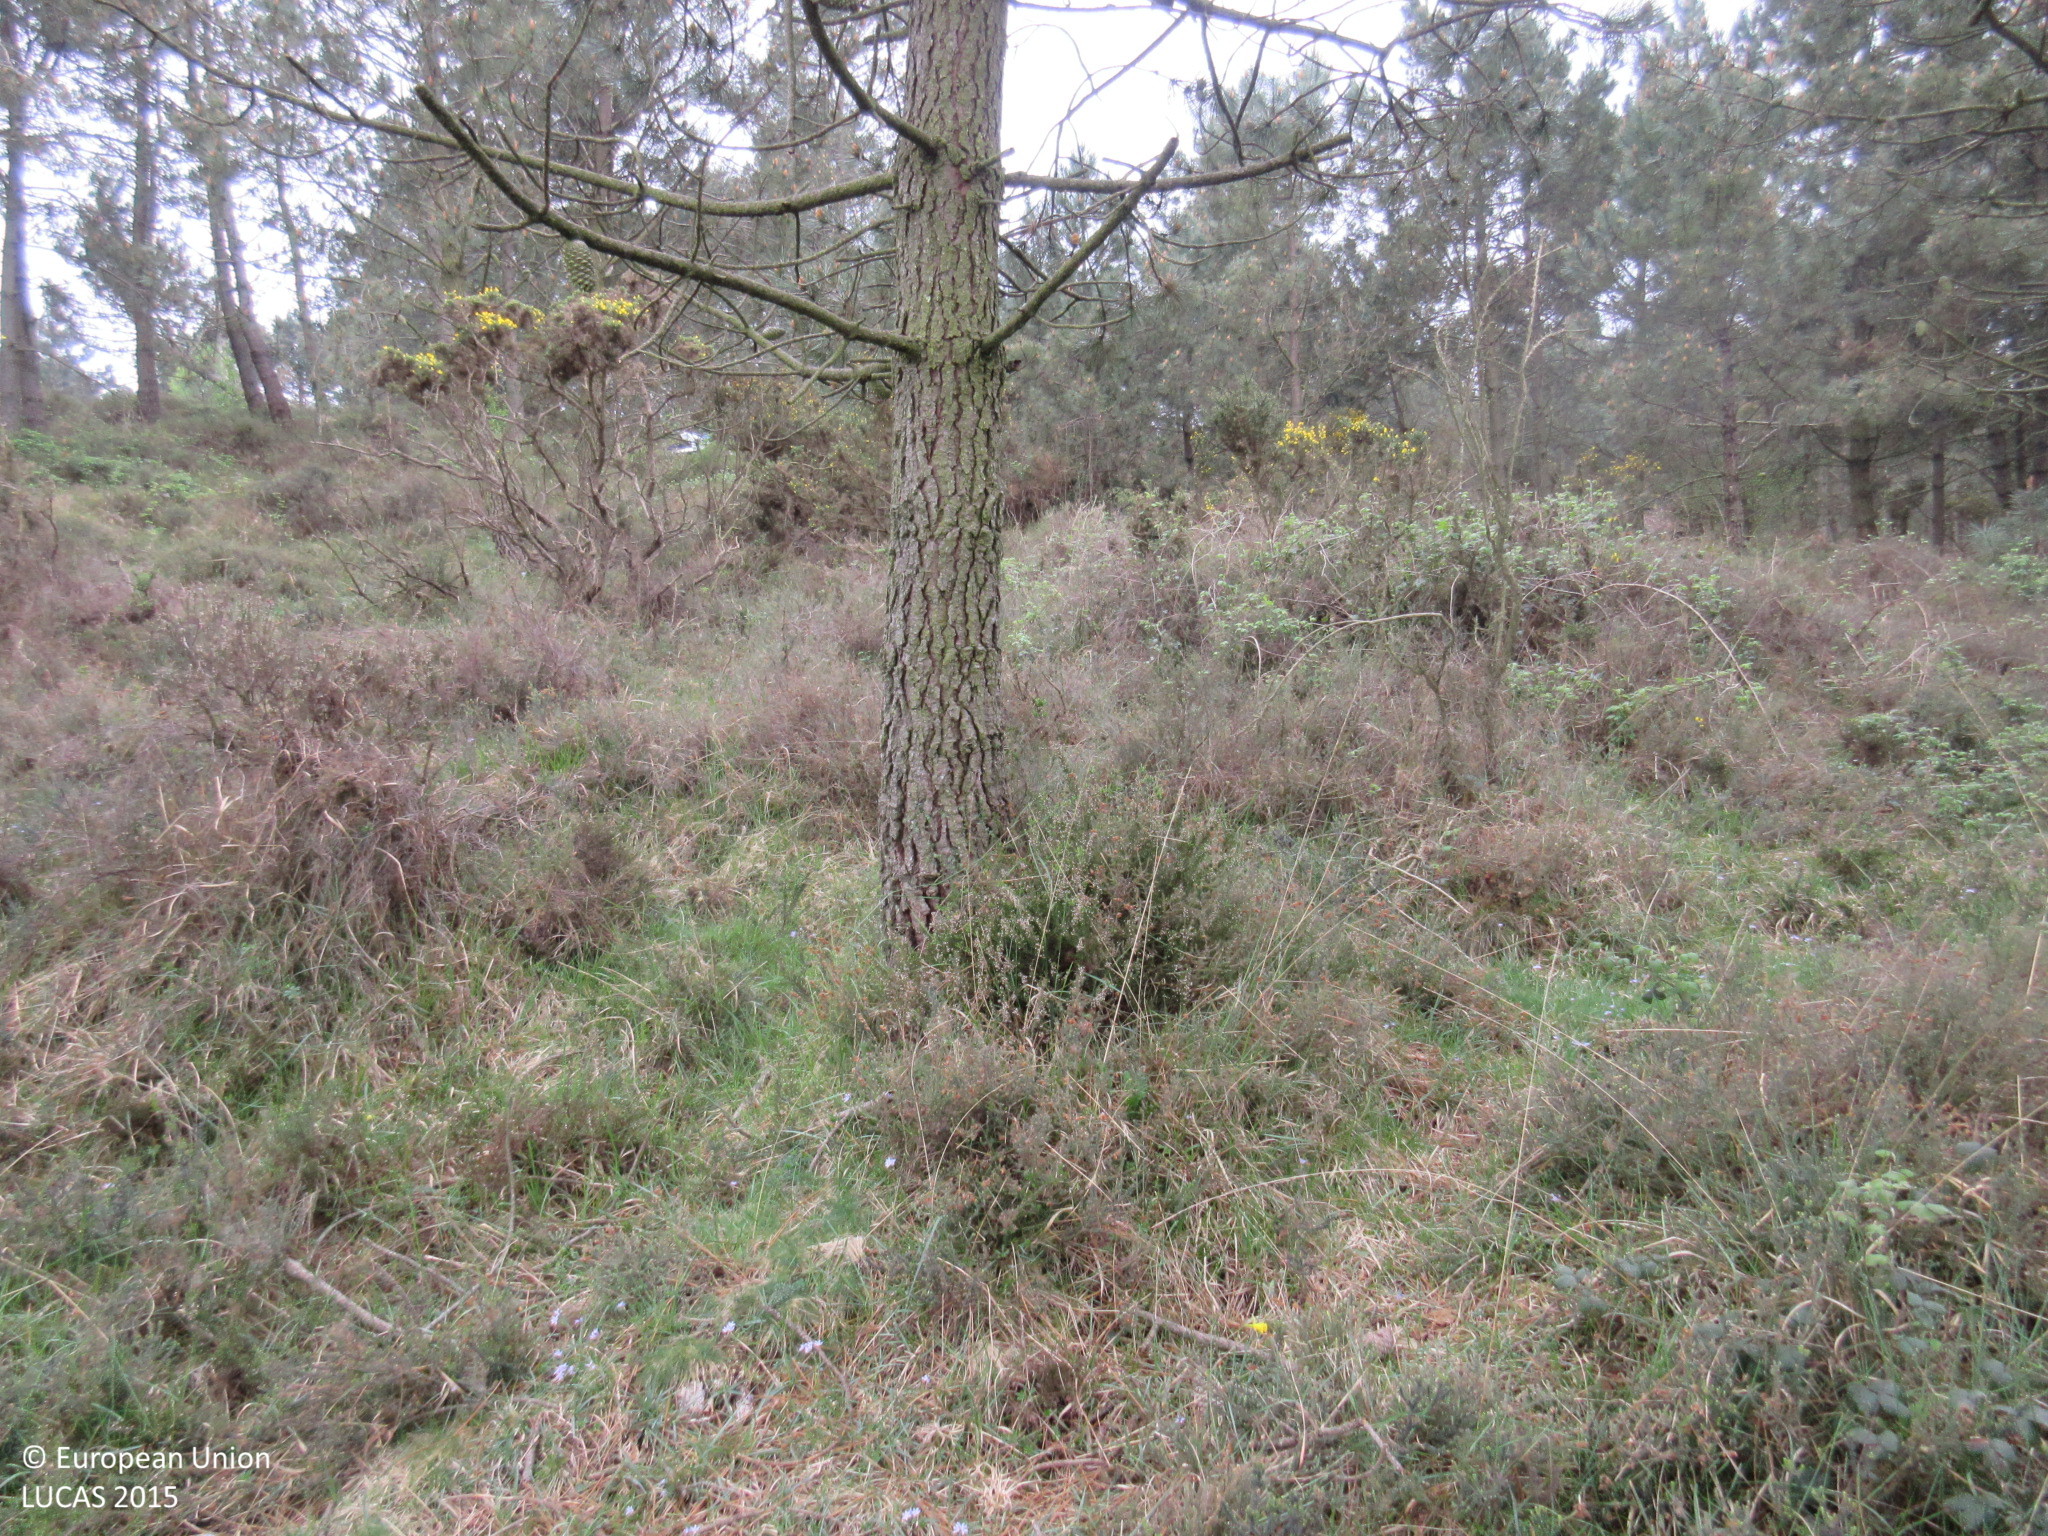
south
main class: Woodland
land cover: Pine dominated coniferous woodland
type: hemiboreal forest and nemoral coniferous forest and mixed broadleaved-coniferous forest
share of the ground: 50 - 75 %
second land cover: Shrubland without tree cover
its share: > 75 %
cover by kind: coniferous forest trees 70 %, shrubs 30 %
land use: Forestry
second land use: Agriculture (excluding fallow land and kitchen gardens)
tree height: > 5 m
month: April
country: ES
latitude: 43.4894
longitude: -6.7673
